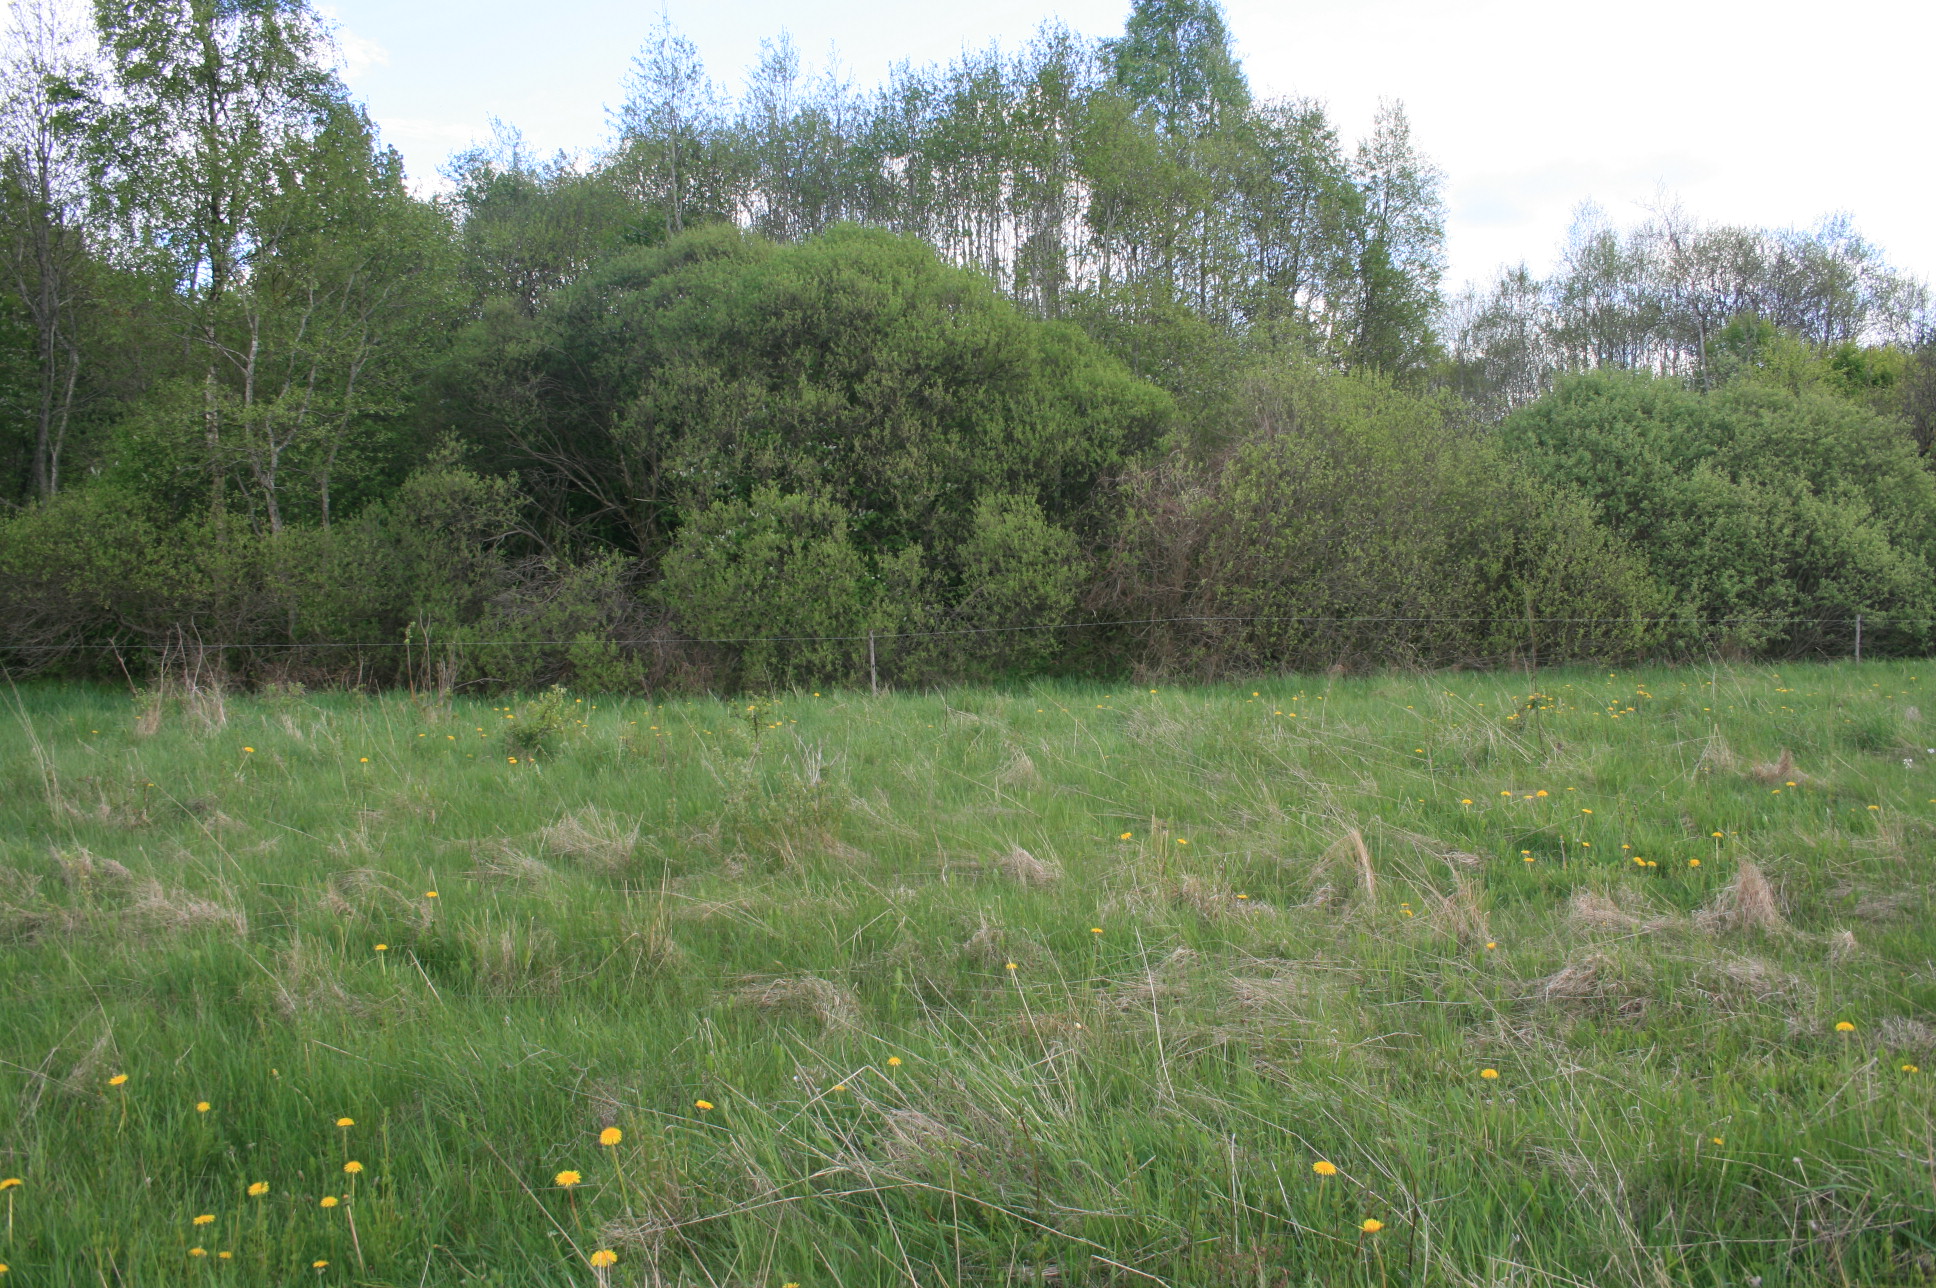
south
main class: Grassland
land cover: Grassland without tree/shrub cover
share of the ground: > 75 %
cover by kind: herbaceous plants 100 %
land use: Agriculture (excluding fallow land and kitchen gardens)
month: May
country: LT
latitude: 56.1783
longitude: 22.0855
